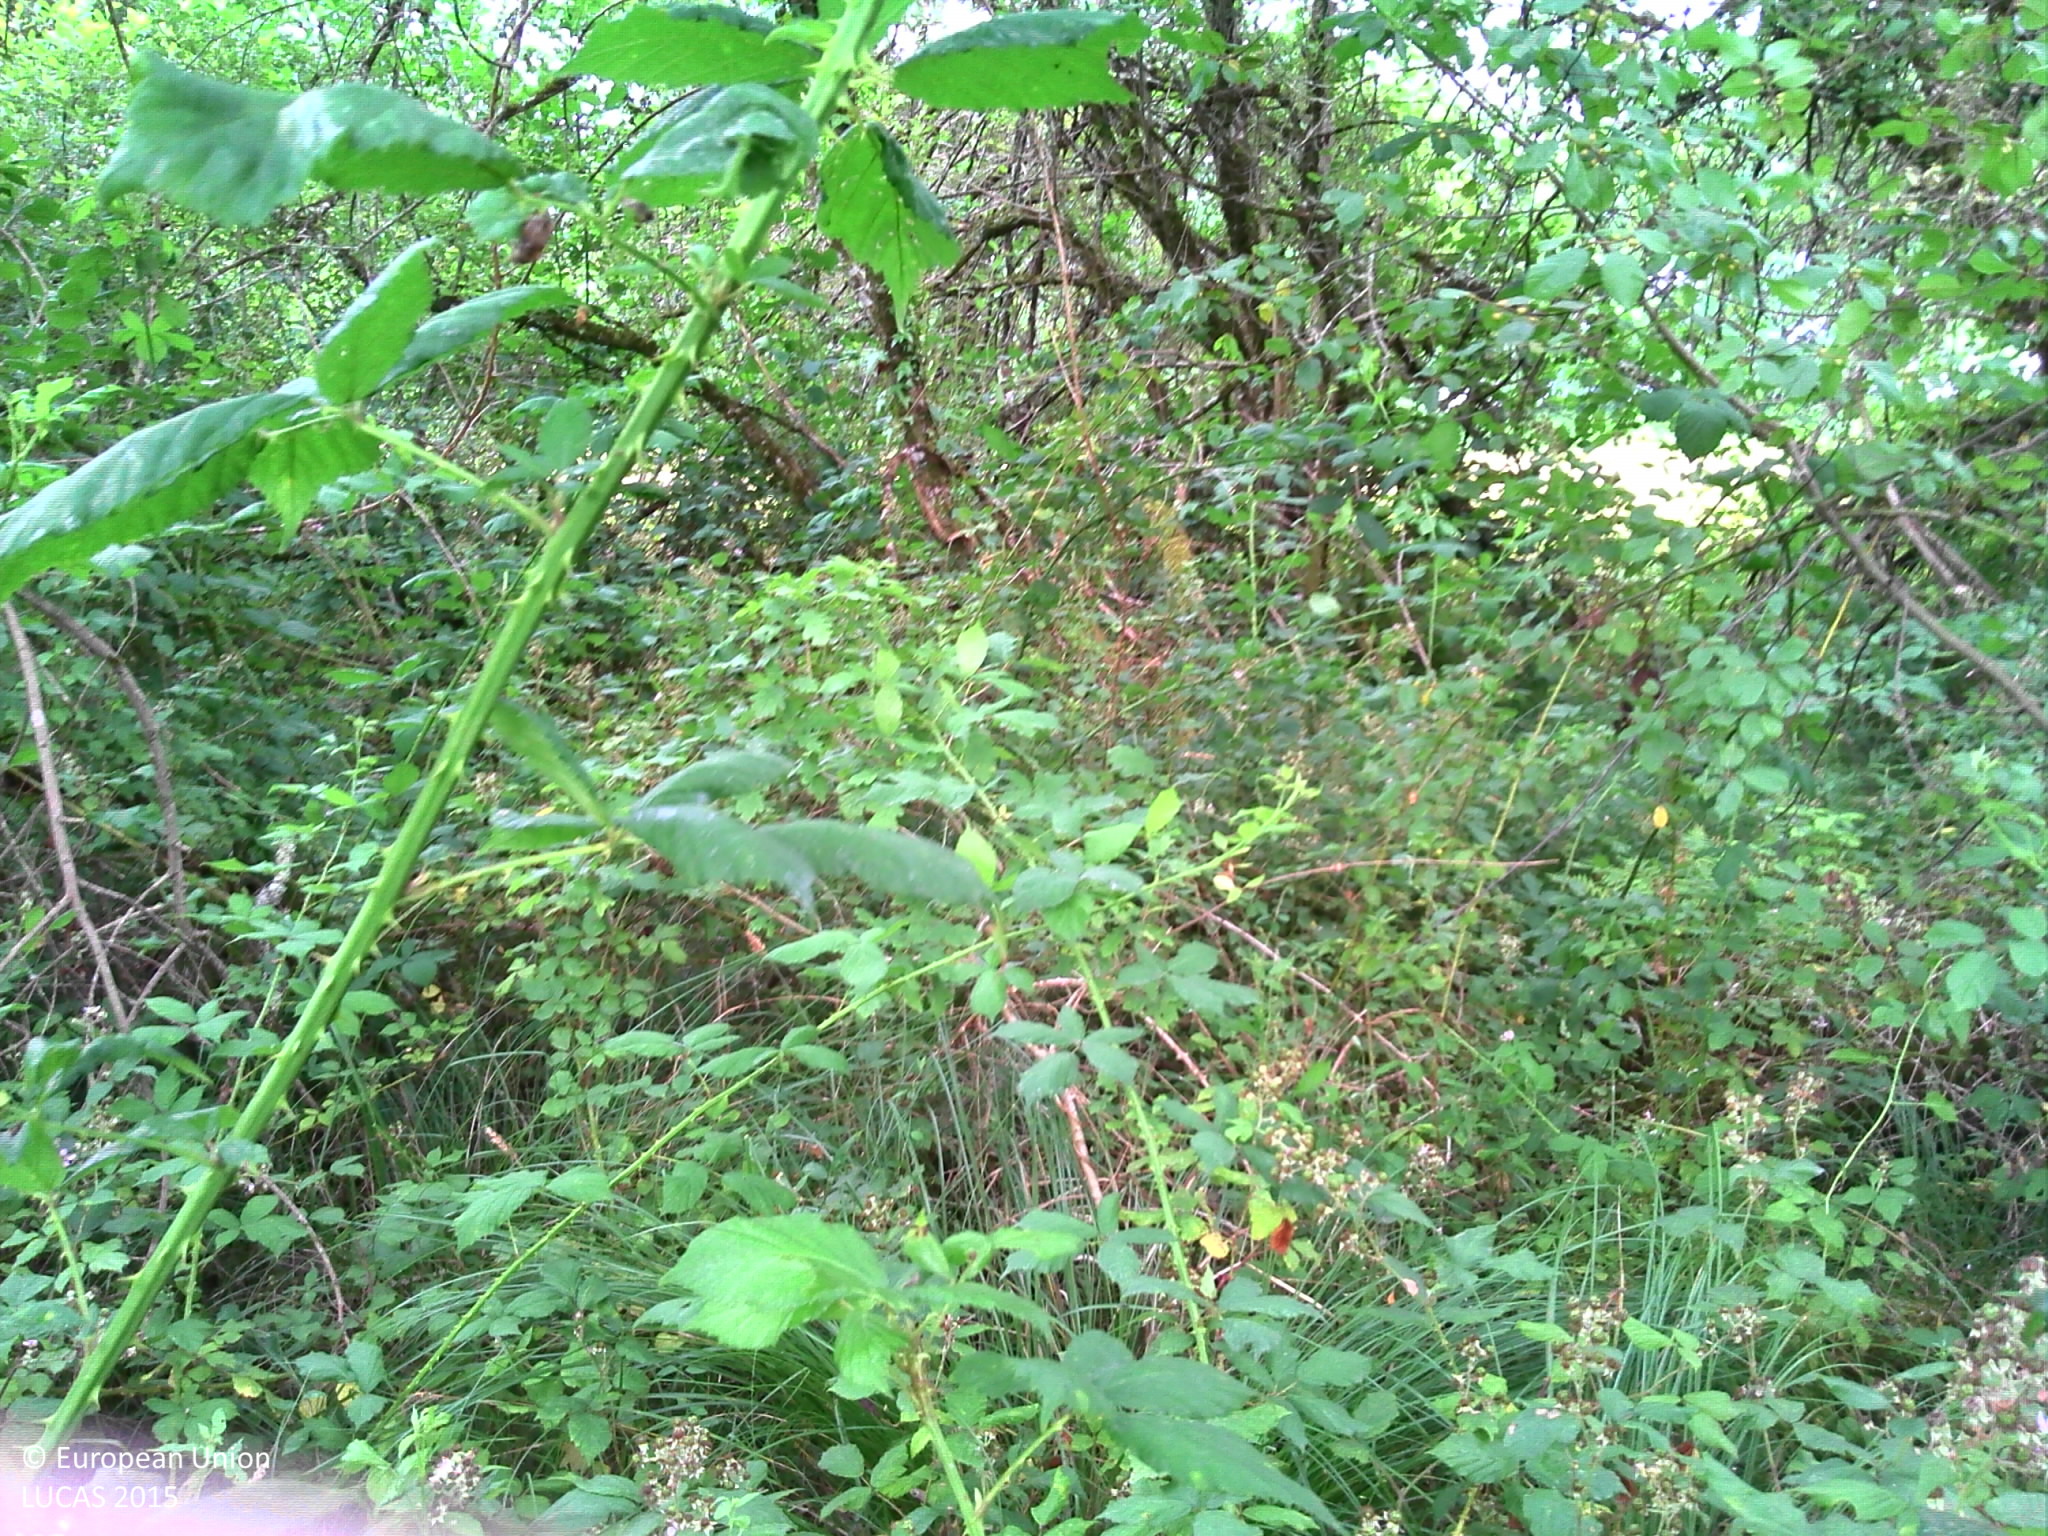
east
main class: Woodland
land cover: Broadleaved woodland
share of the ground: 25 - 50 %
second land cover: Spontaneously vegetated surfaces
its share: 50 - 75 %
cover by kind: herbaceous plants 65 %, broadleaved forest trees 25 %
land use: Agriculture (excluding fallow land and kitchen gardens)
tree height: < 5 m
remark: Temporary flooded
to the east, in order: Broadleaved woodland; Spontaneously vegetated surfaces; Rivers and streams; Grassland without tree/shrub cover; Spontaneously vegetated surfaces; Lines of trees; Grassland without tree/shrub cover; Fences; Temporary grasslands; Fences; Lines of trees; Grass margins; Tracks; Grassland without tree/shrub cover
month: July
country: FR
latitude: 45.7096
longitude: 0.7003
